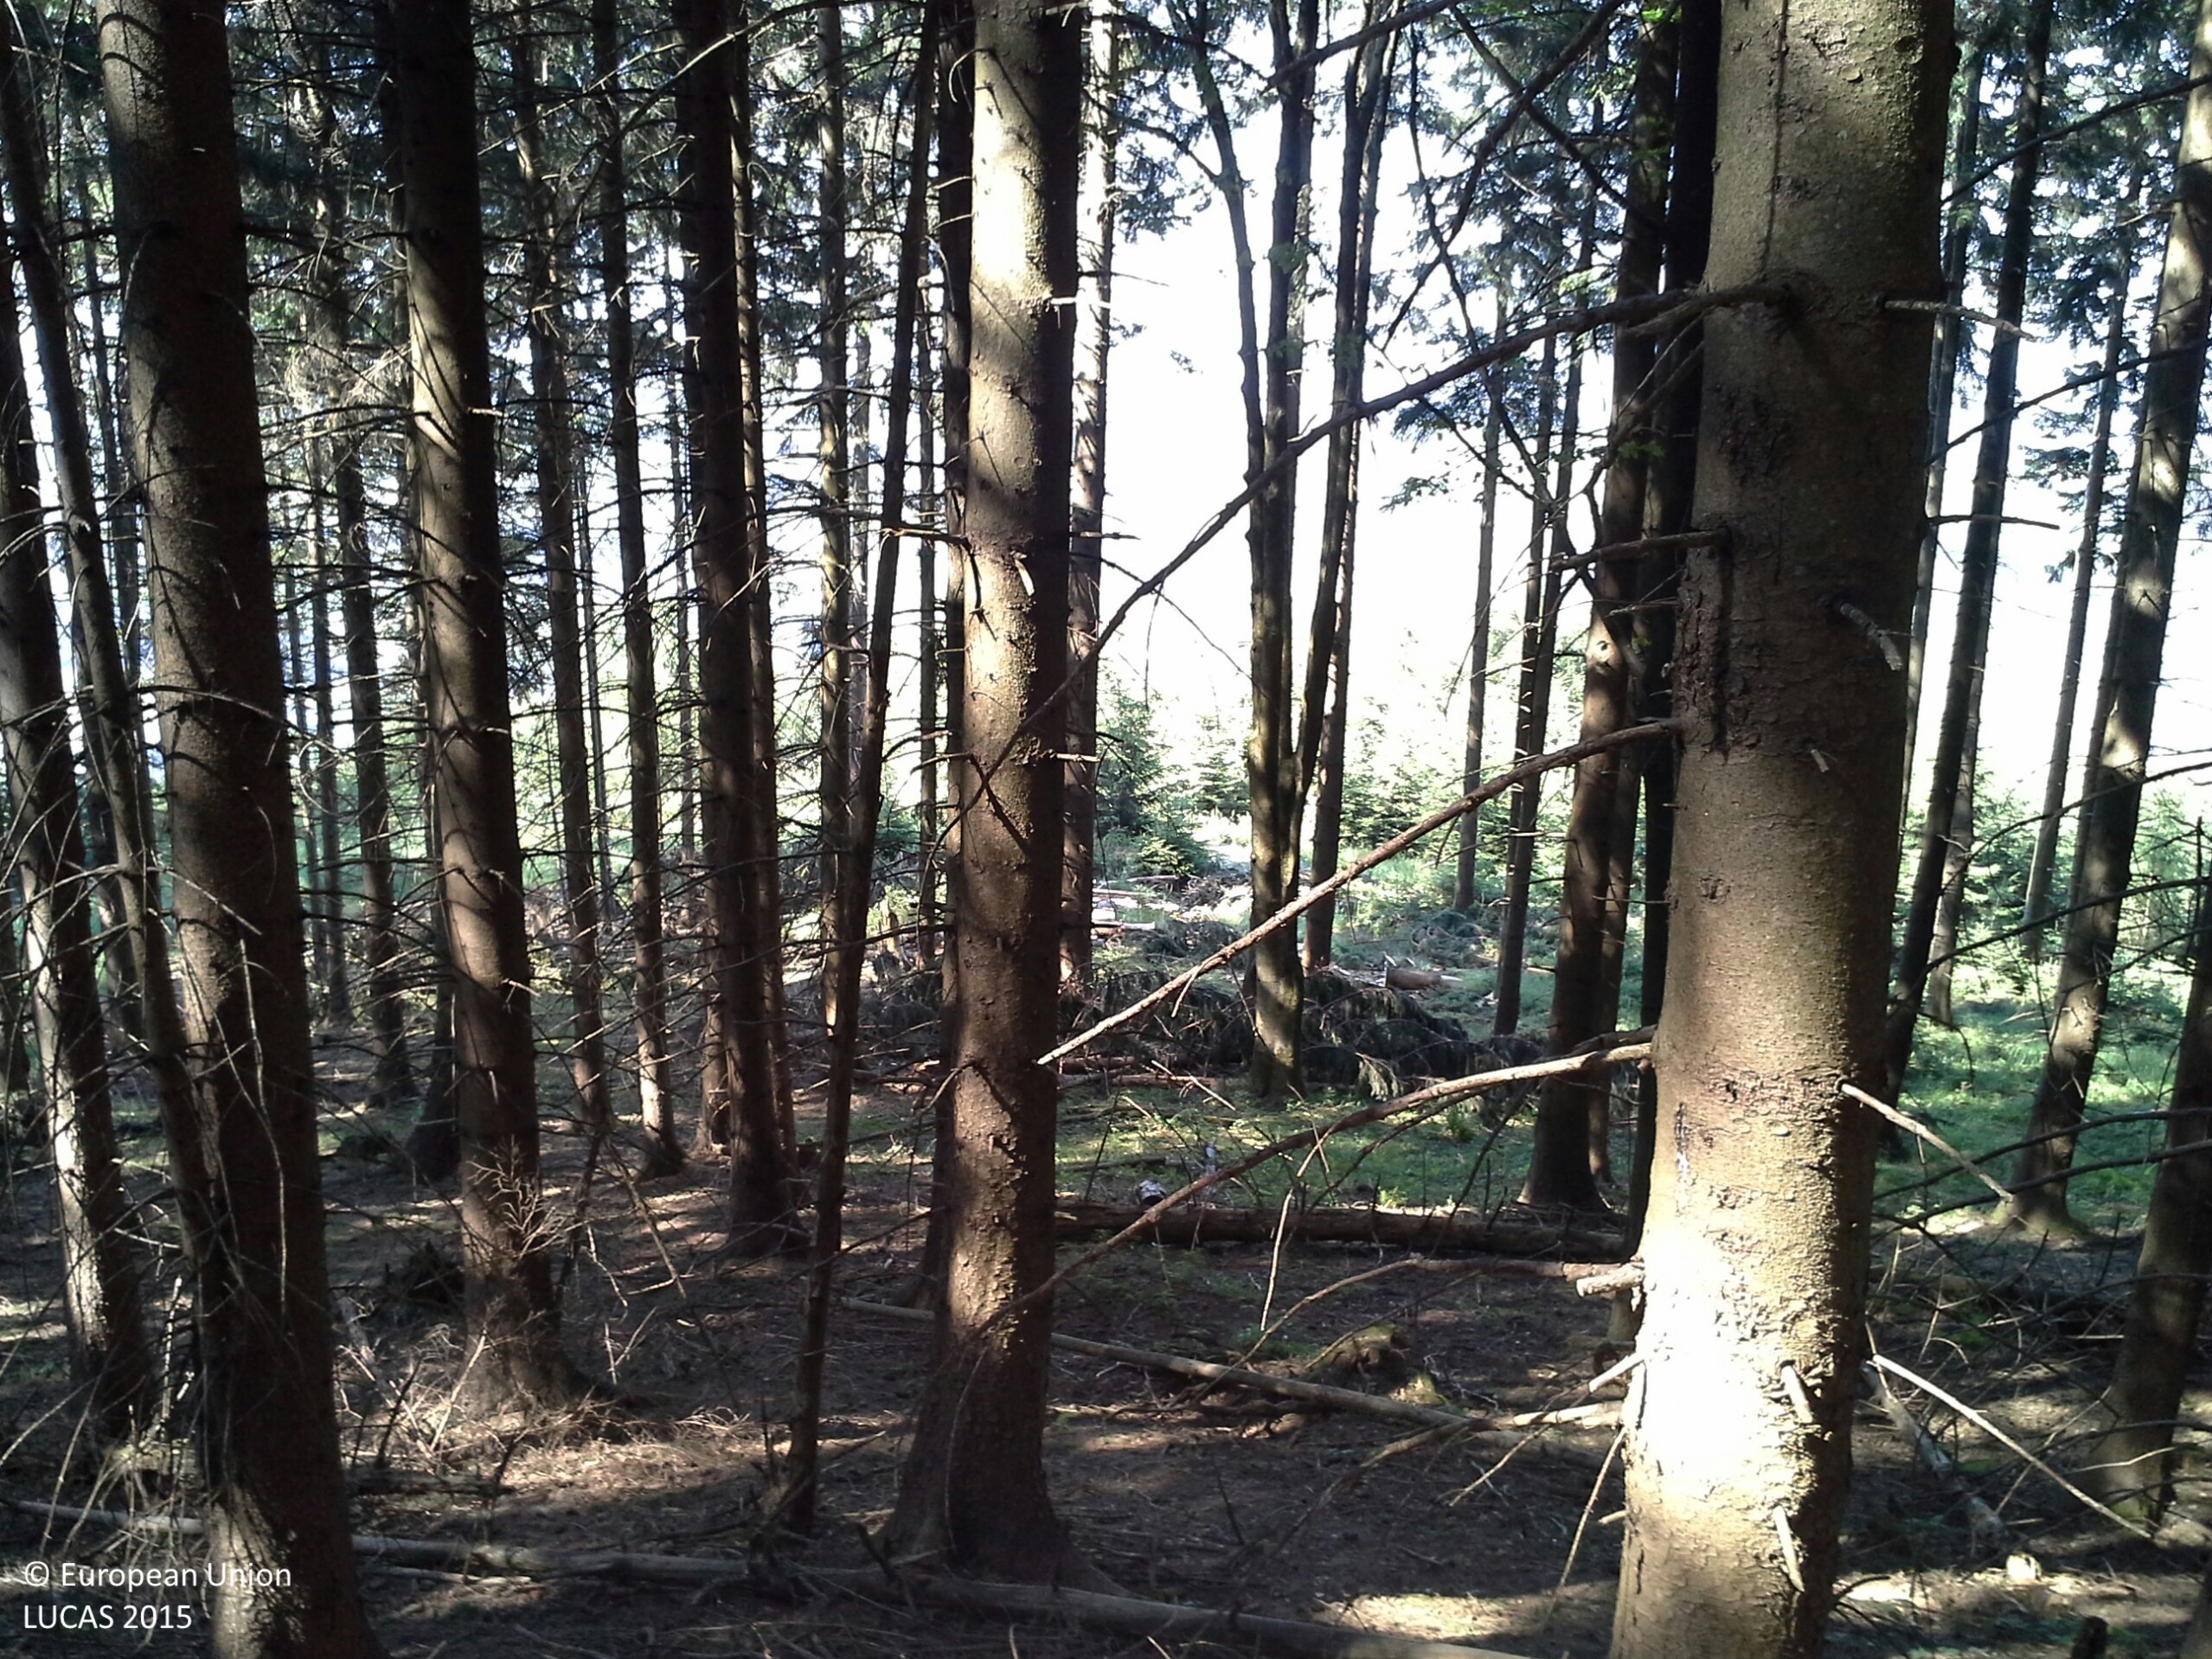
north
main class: Woodland
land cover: Spruce dominated coniferous woodland
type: alpine coniferous forest
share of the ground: > 75 %
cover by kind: coniferous forest trees 90 %, herbaceous plants 10 %
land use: Forestry
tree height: > 5 m
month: July
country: AT
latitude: 47.9611
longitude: 14.7010
